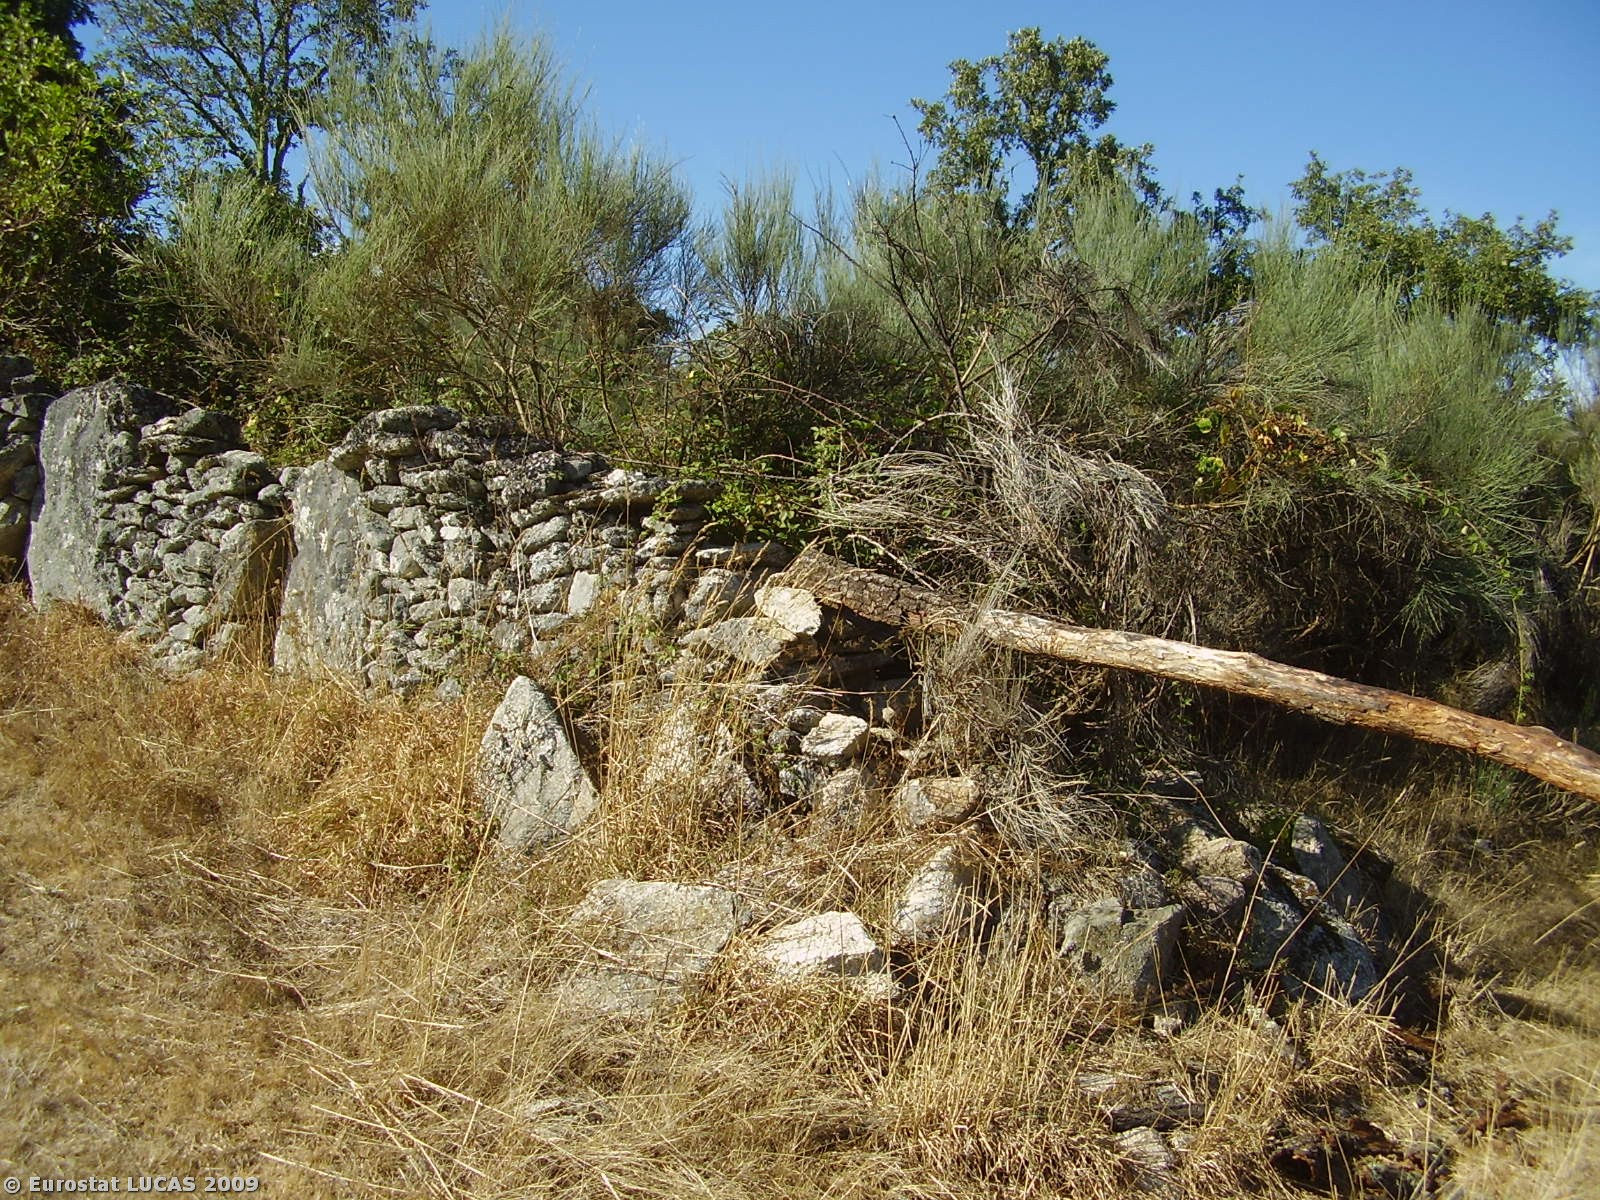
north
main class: Grassland
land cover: Grassland without tree/shrub cover
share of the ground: > 75 %
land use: Fallow land
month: September
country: PT
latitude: 41.7696
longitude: -7.6627
